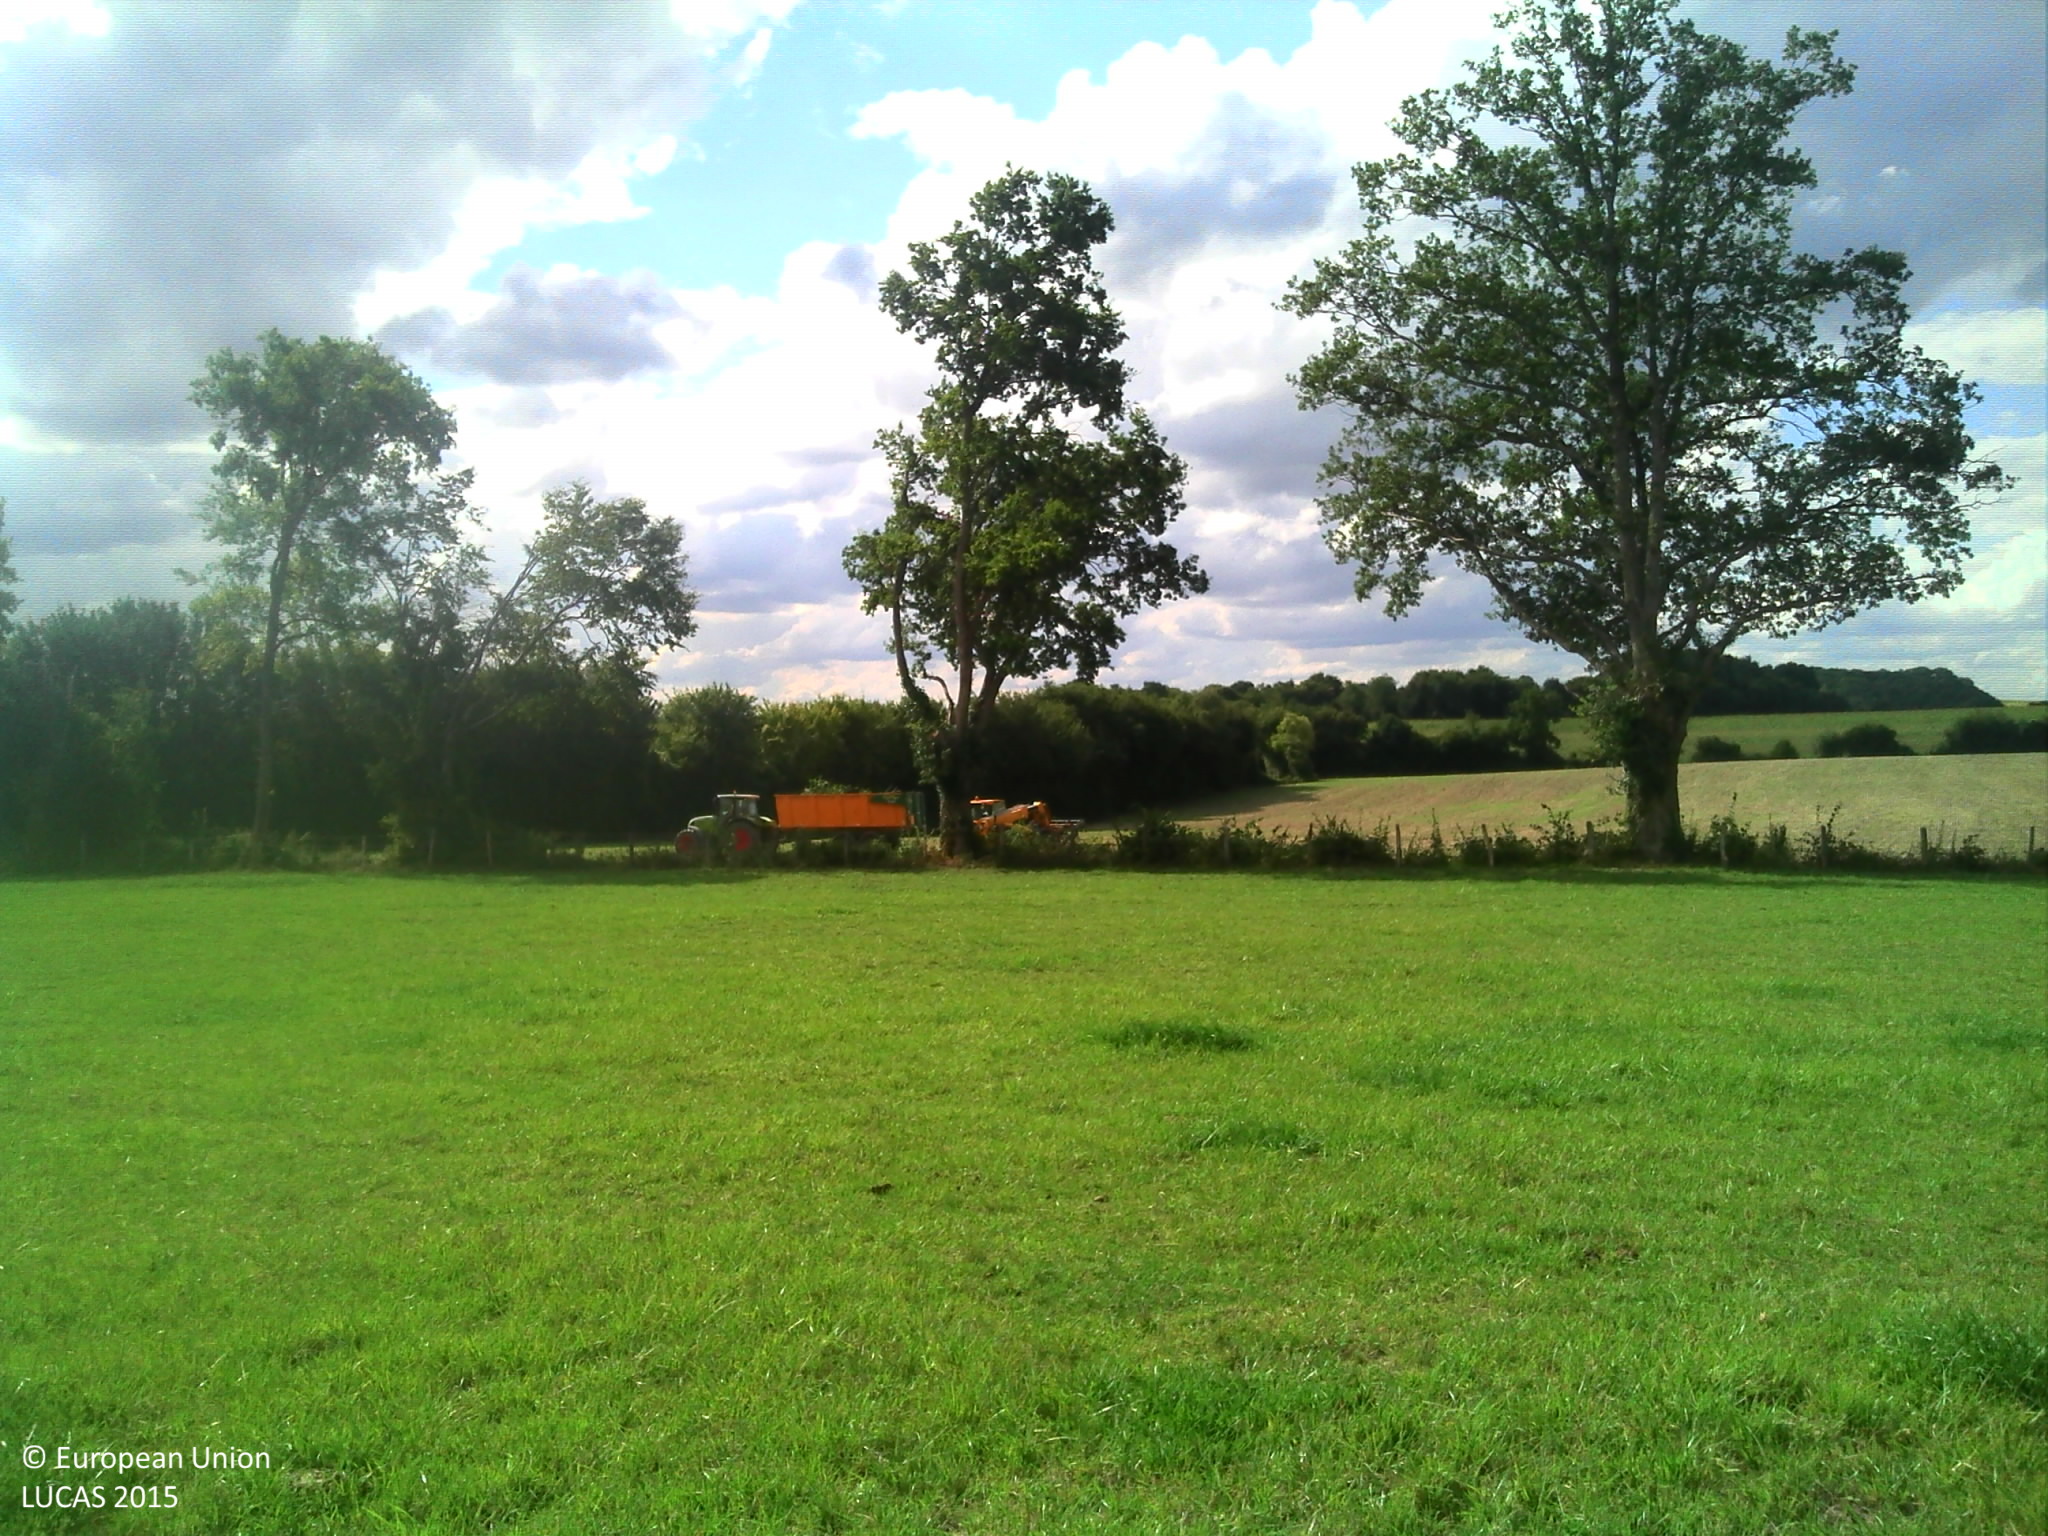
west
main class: Grassland
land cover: Grassland without tree/shrub cover
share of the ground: > 75 %
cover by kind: herbaceous plants 100 %
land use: Agriculture (excluding fallow land and kitchen gardens)
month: September
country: FR
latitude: 48.2905
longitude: 0.5821
